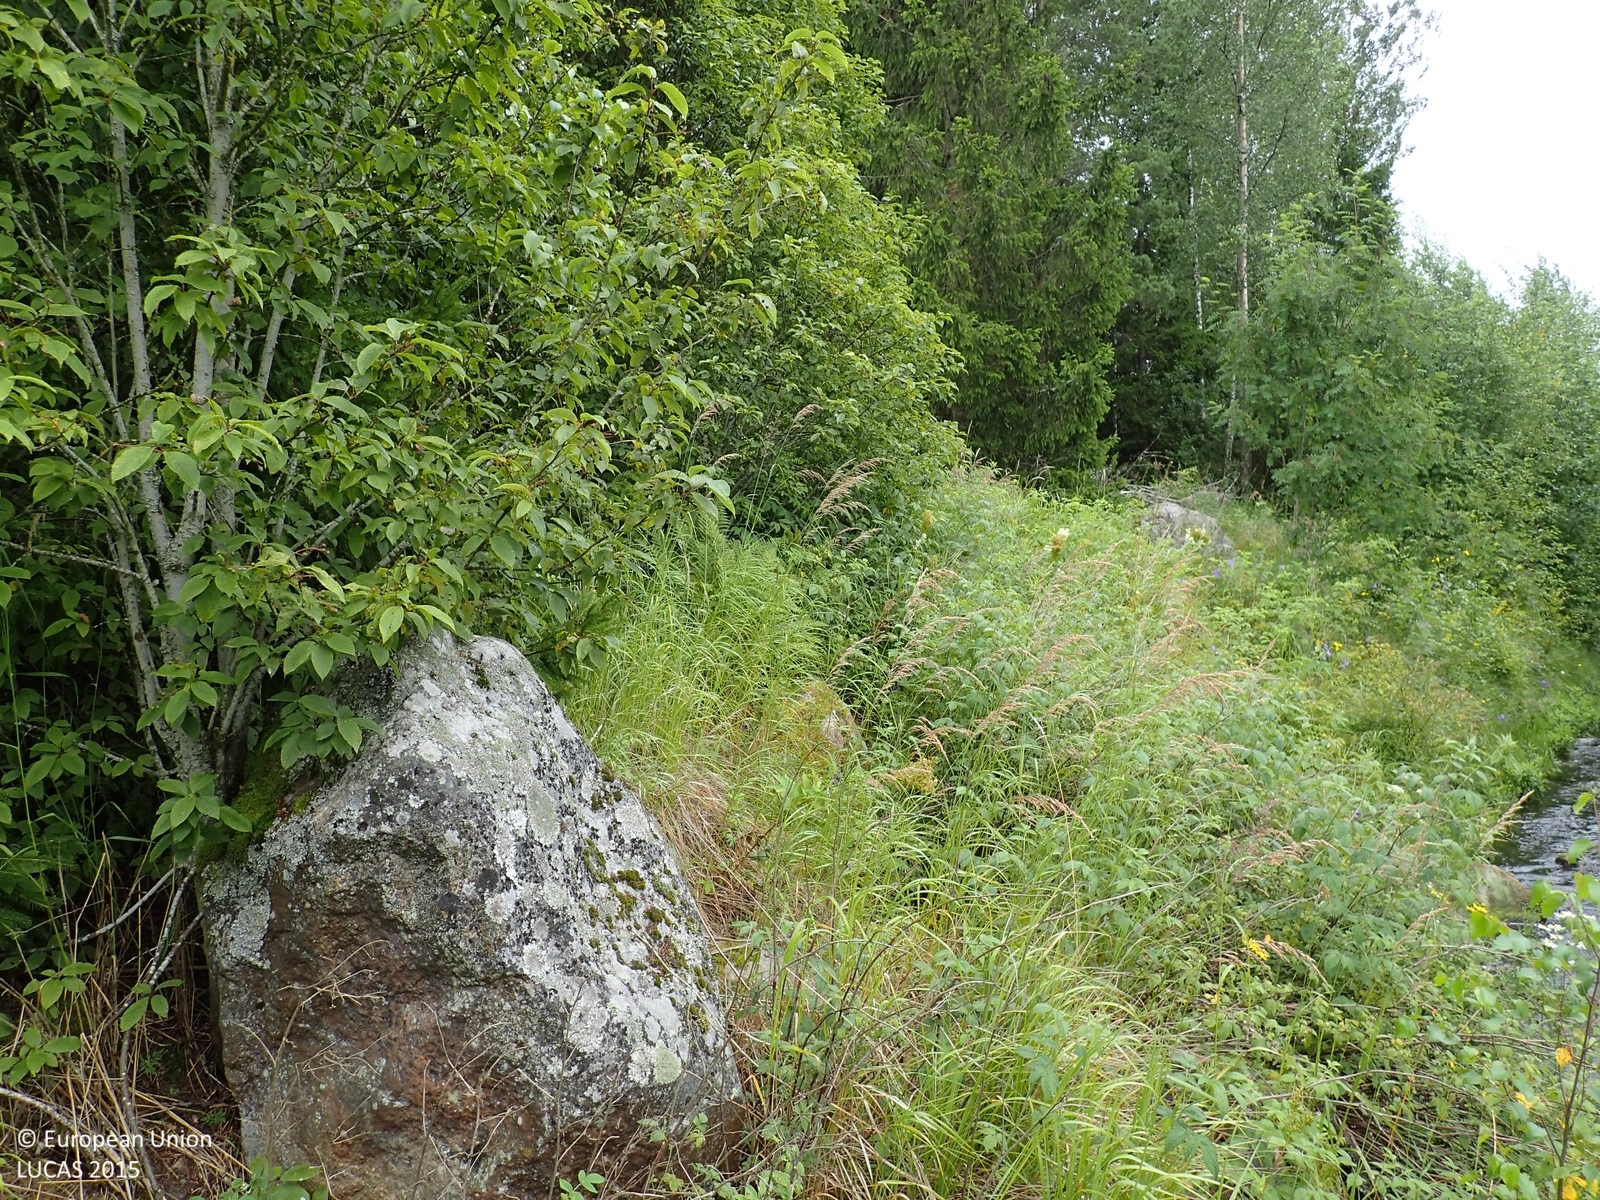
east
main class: Cropland
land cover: Common wheat
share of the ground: > 75 %
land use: Agriculture (excluding fallow land and kitchen gardens)
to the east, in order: Common wheat; Shruby margins; Ditches and canals; Shruby margins; Common wheat; Shruby margins; Ditches and canals; Other mixed woodland; Grass margins; Paved roads, cycling and walking lanes; Grass margins; Ditches and canals; Shruby margins; Common wheat
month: August
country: FI
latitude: 62.9108
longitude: 22.0735
